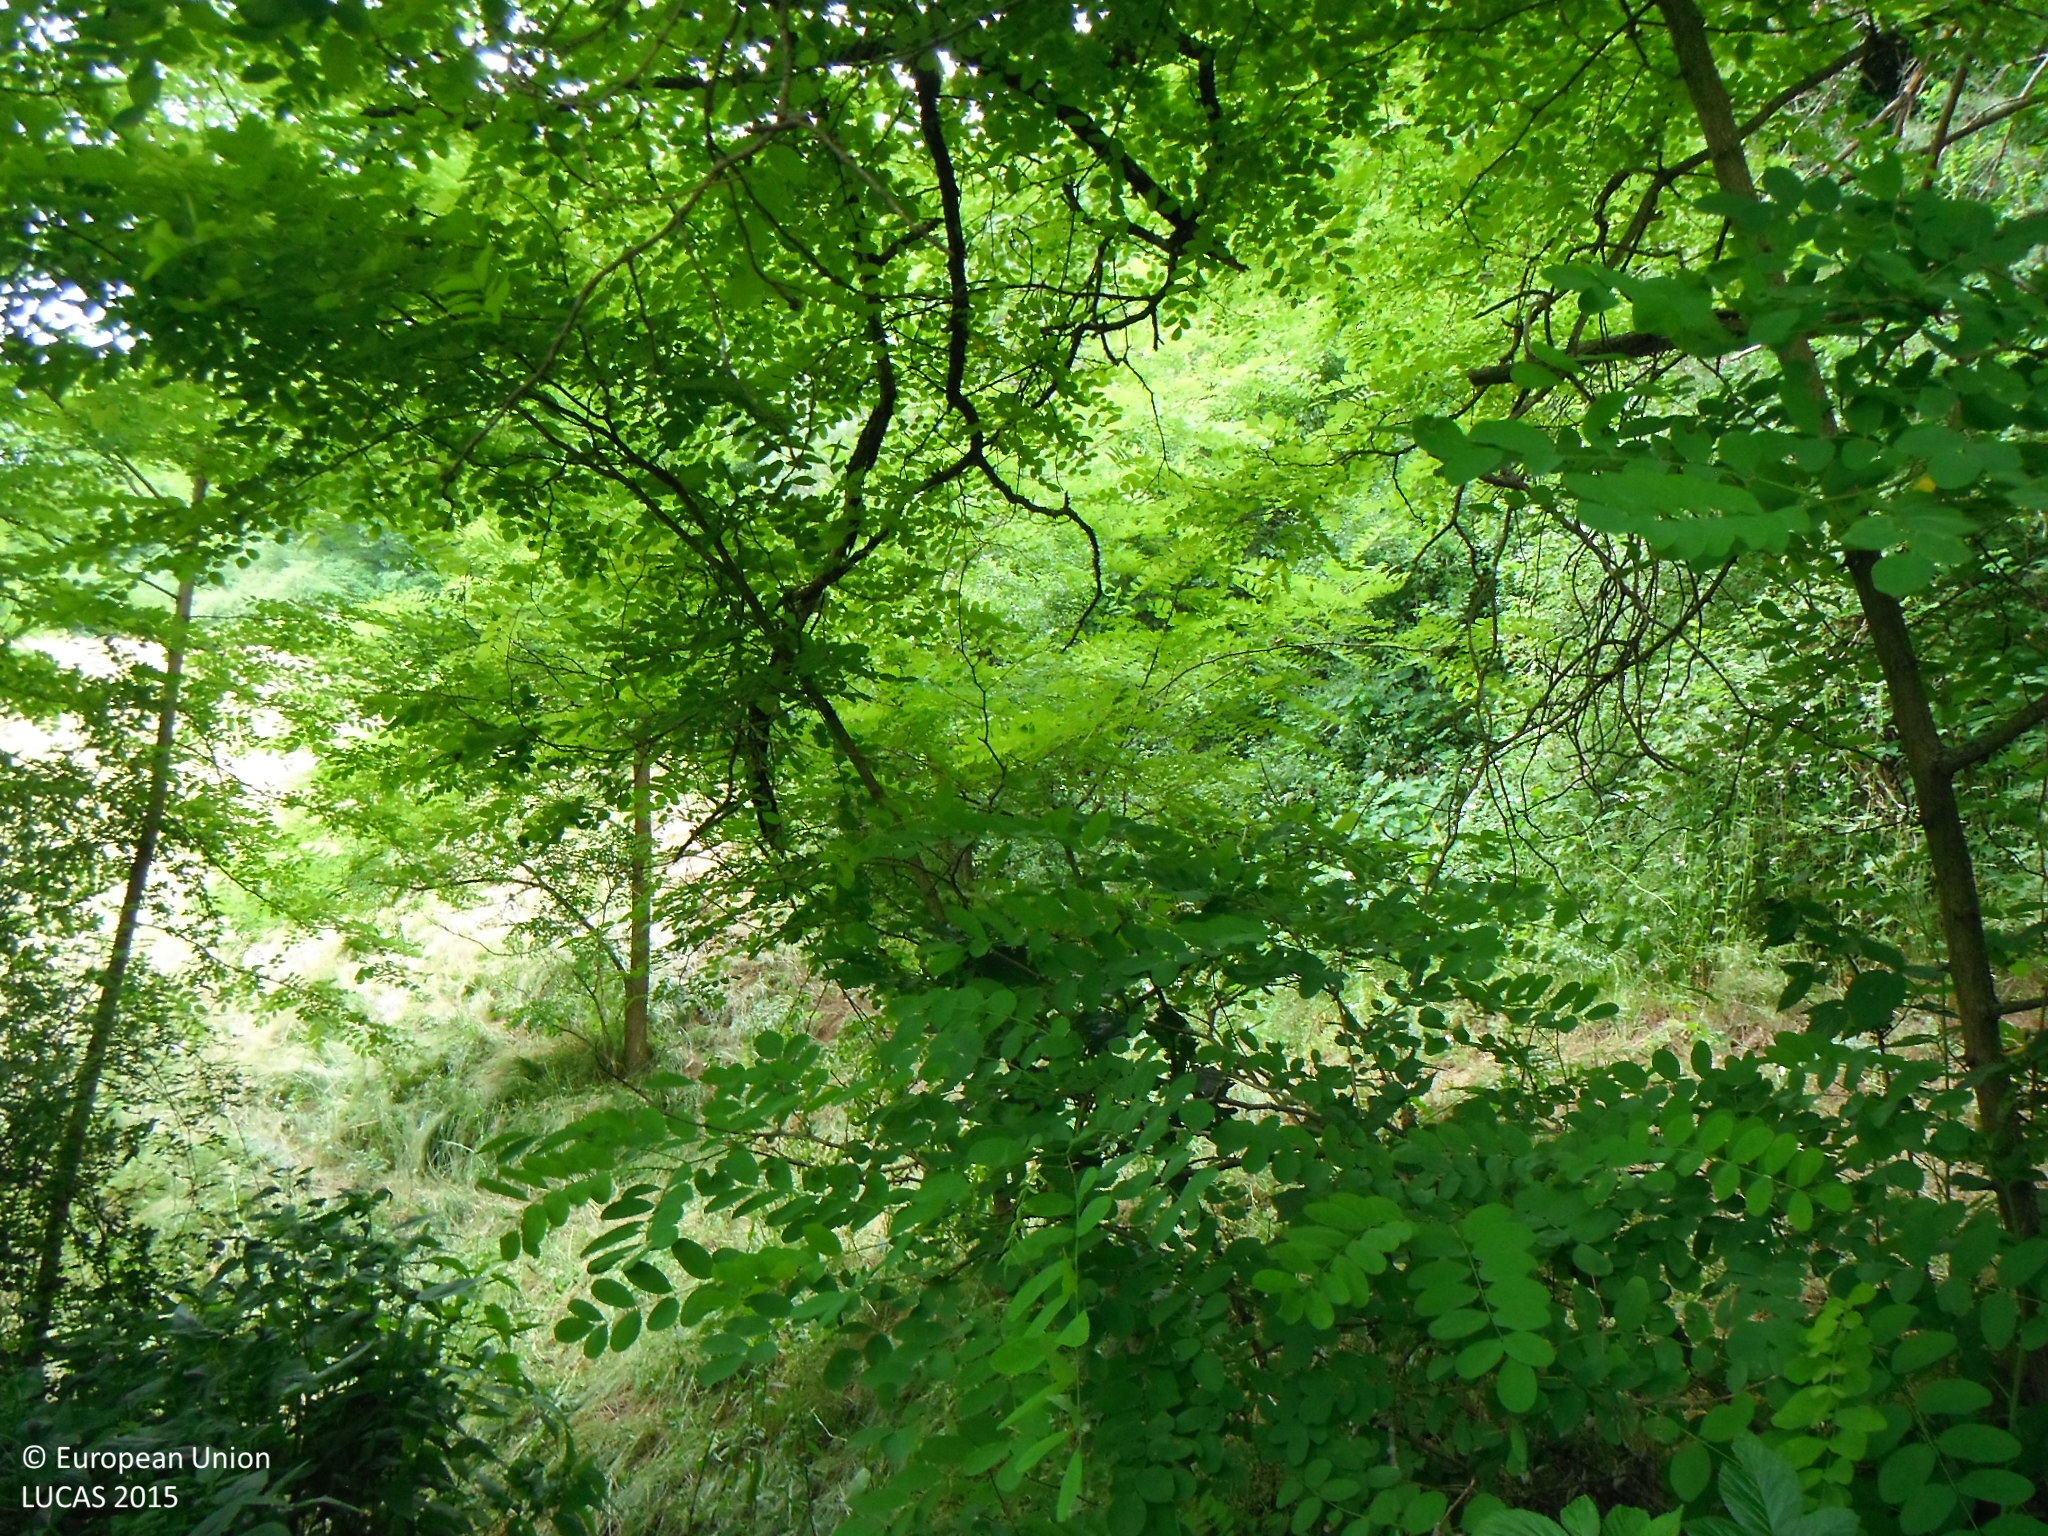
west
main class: Woodland
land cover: Broadleaved woodland
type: exotic forest
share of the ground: > 75 %
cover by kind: broadleaved forest trees 80 %, shrubs 10 %, herbaceous plants 10 %
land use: Forestry
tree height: > 5 m
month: June
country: SK
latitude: 48.5793
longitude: 20.0473
